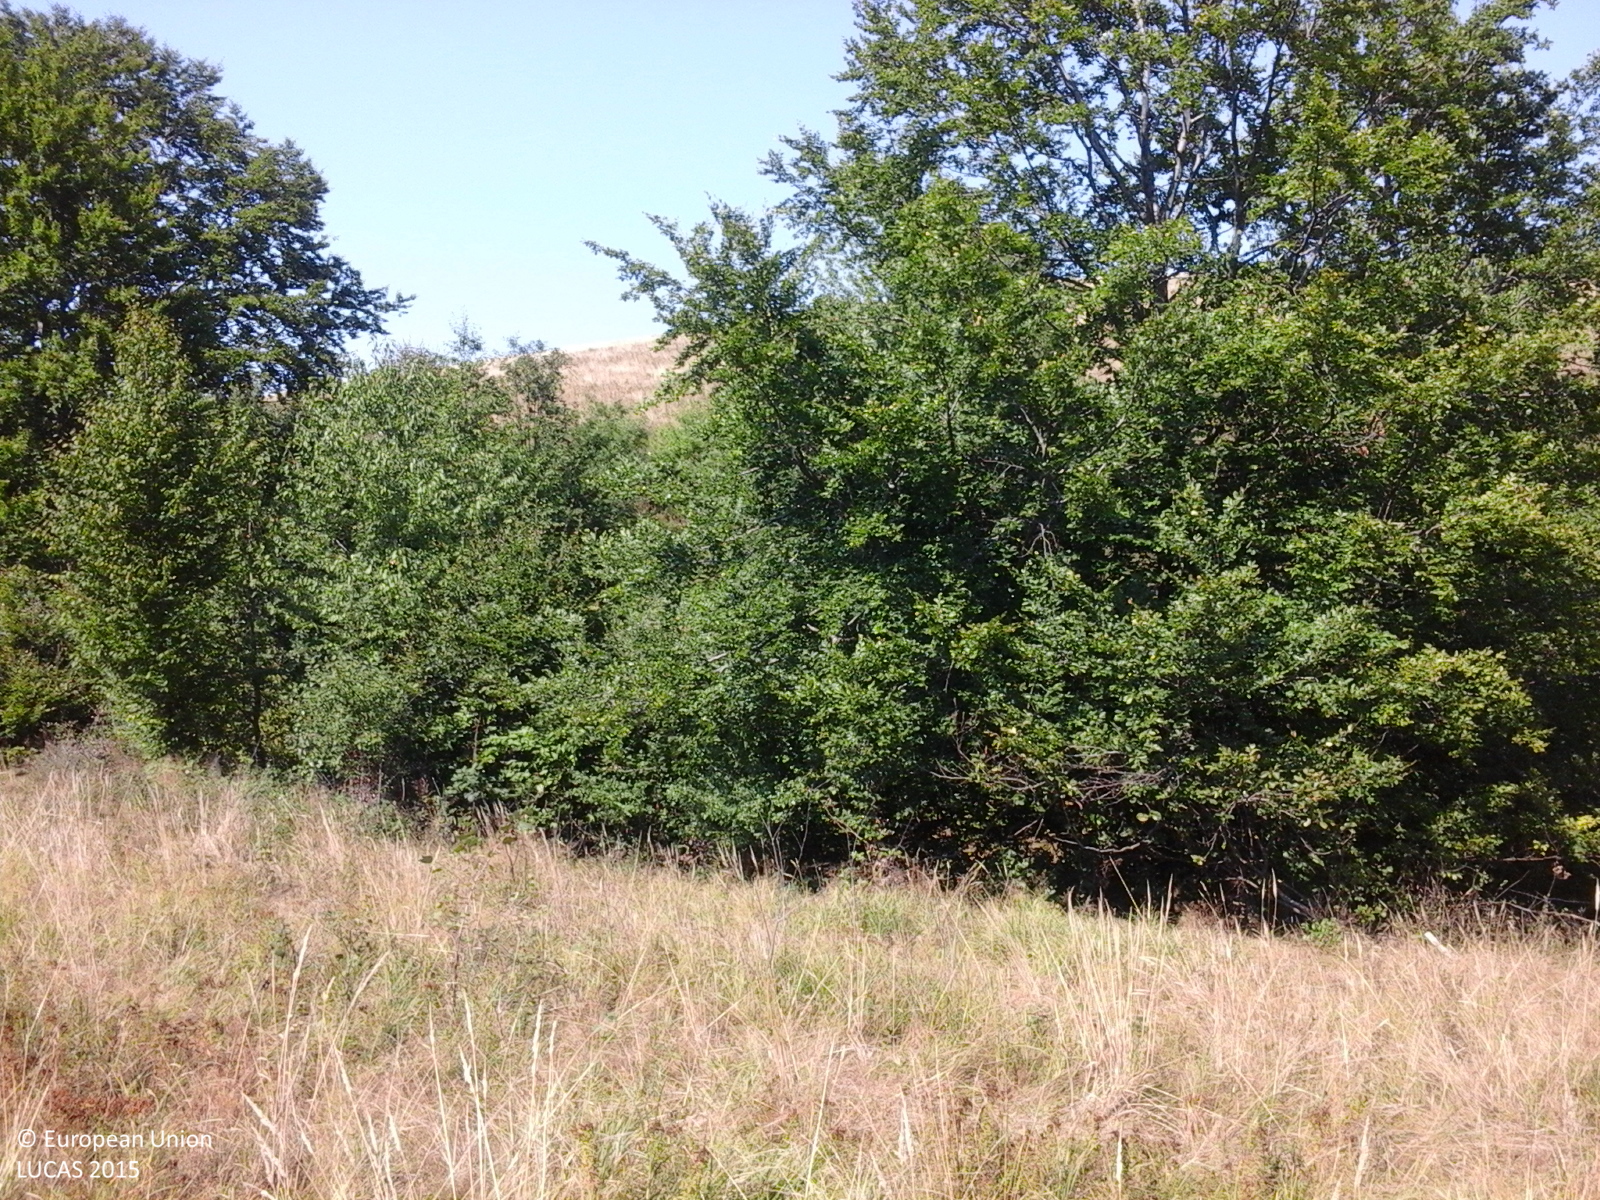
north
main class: Grassland
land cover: Grassland without tree/shrub cover
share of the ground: > 75 %
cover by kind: herbaceous plants 100 %
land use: Agriculture (excluding fallow land and kitchen gardens)
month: August
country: RO
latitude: 45.8594
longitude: 22.7378
